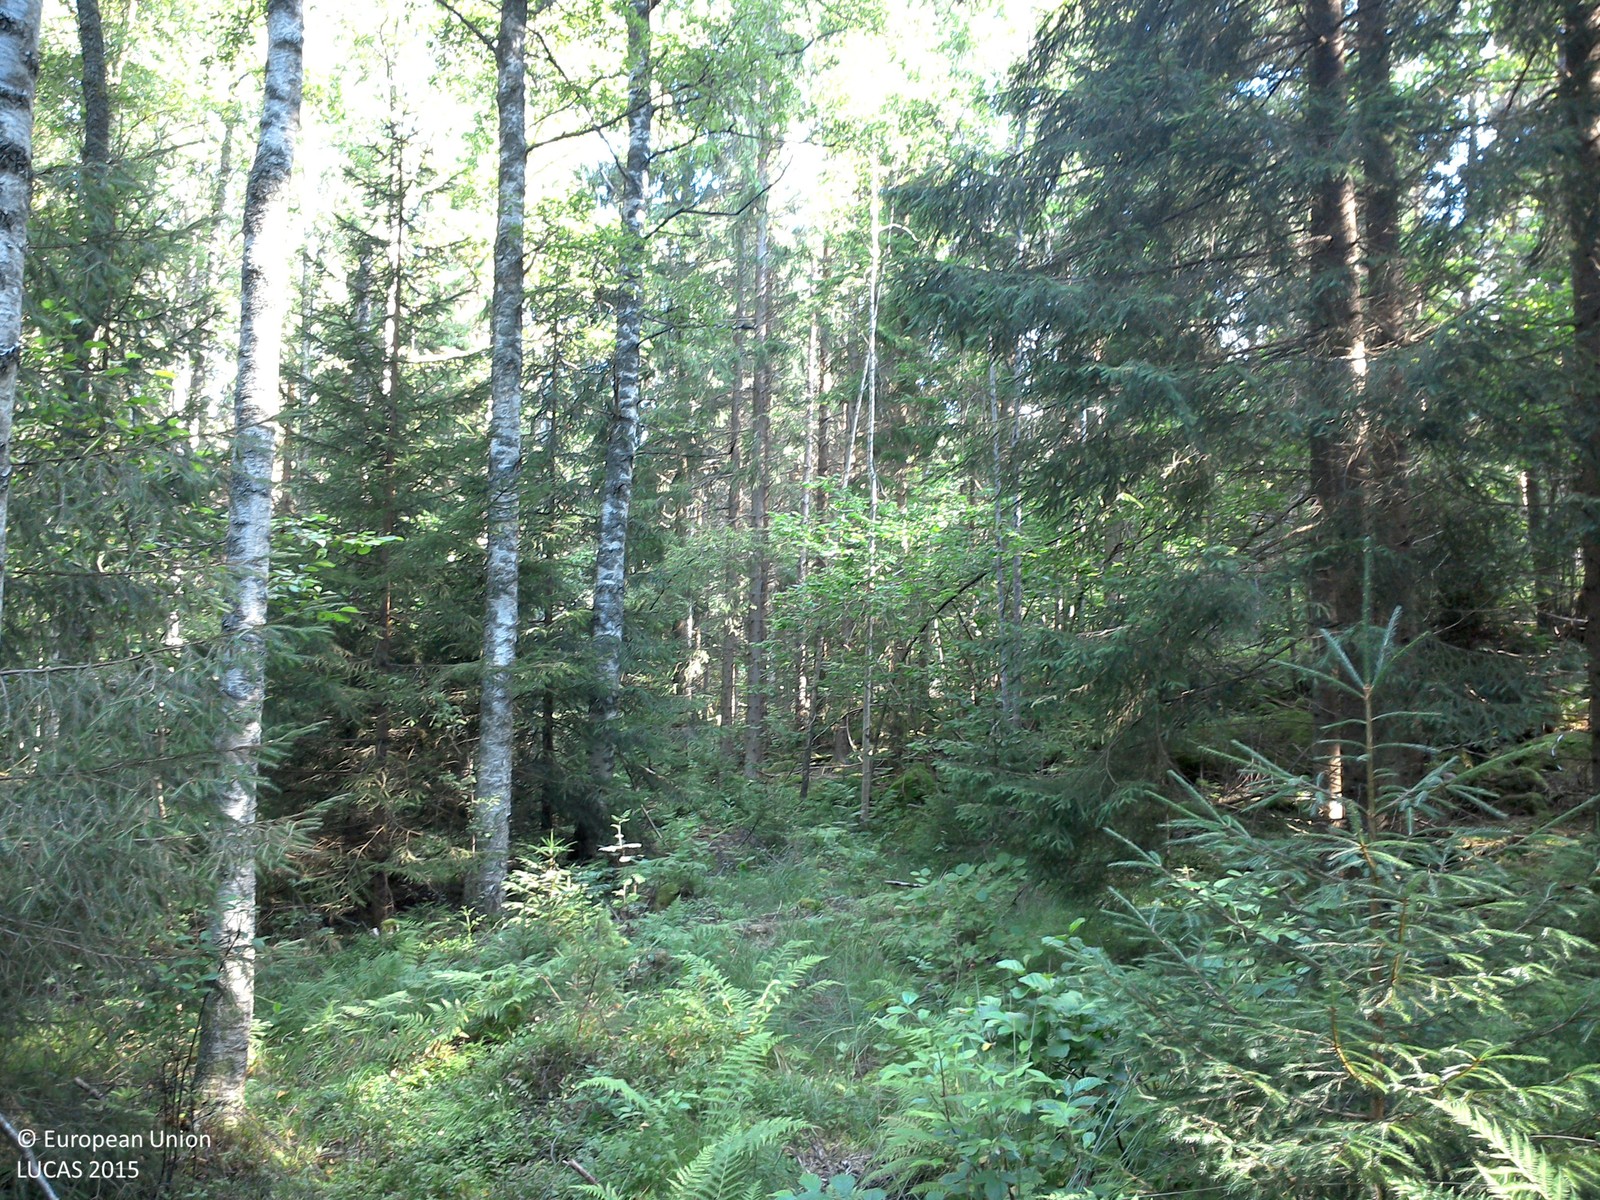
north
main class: Grassland
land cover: Grassland with sparse tree/shrub cover
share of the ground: > 75 %
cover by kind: herbaceous plants 90 %, broadleaved forest trees 5 %
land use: Agriculture (excluding fallow land and kitchen gardens)
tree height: > 5 m
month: August
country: SE
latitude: 58.1685
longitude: 14.8392
